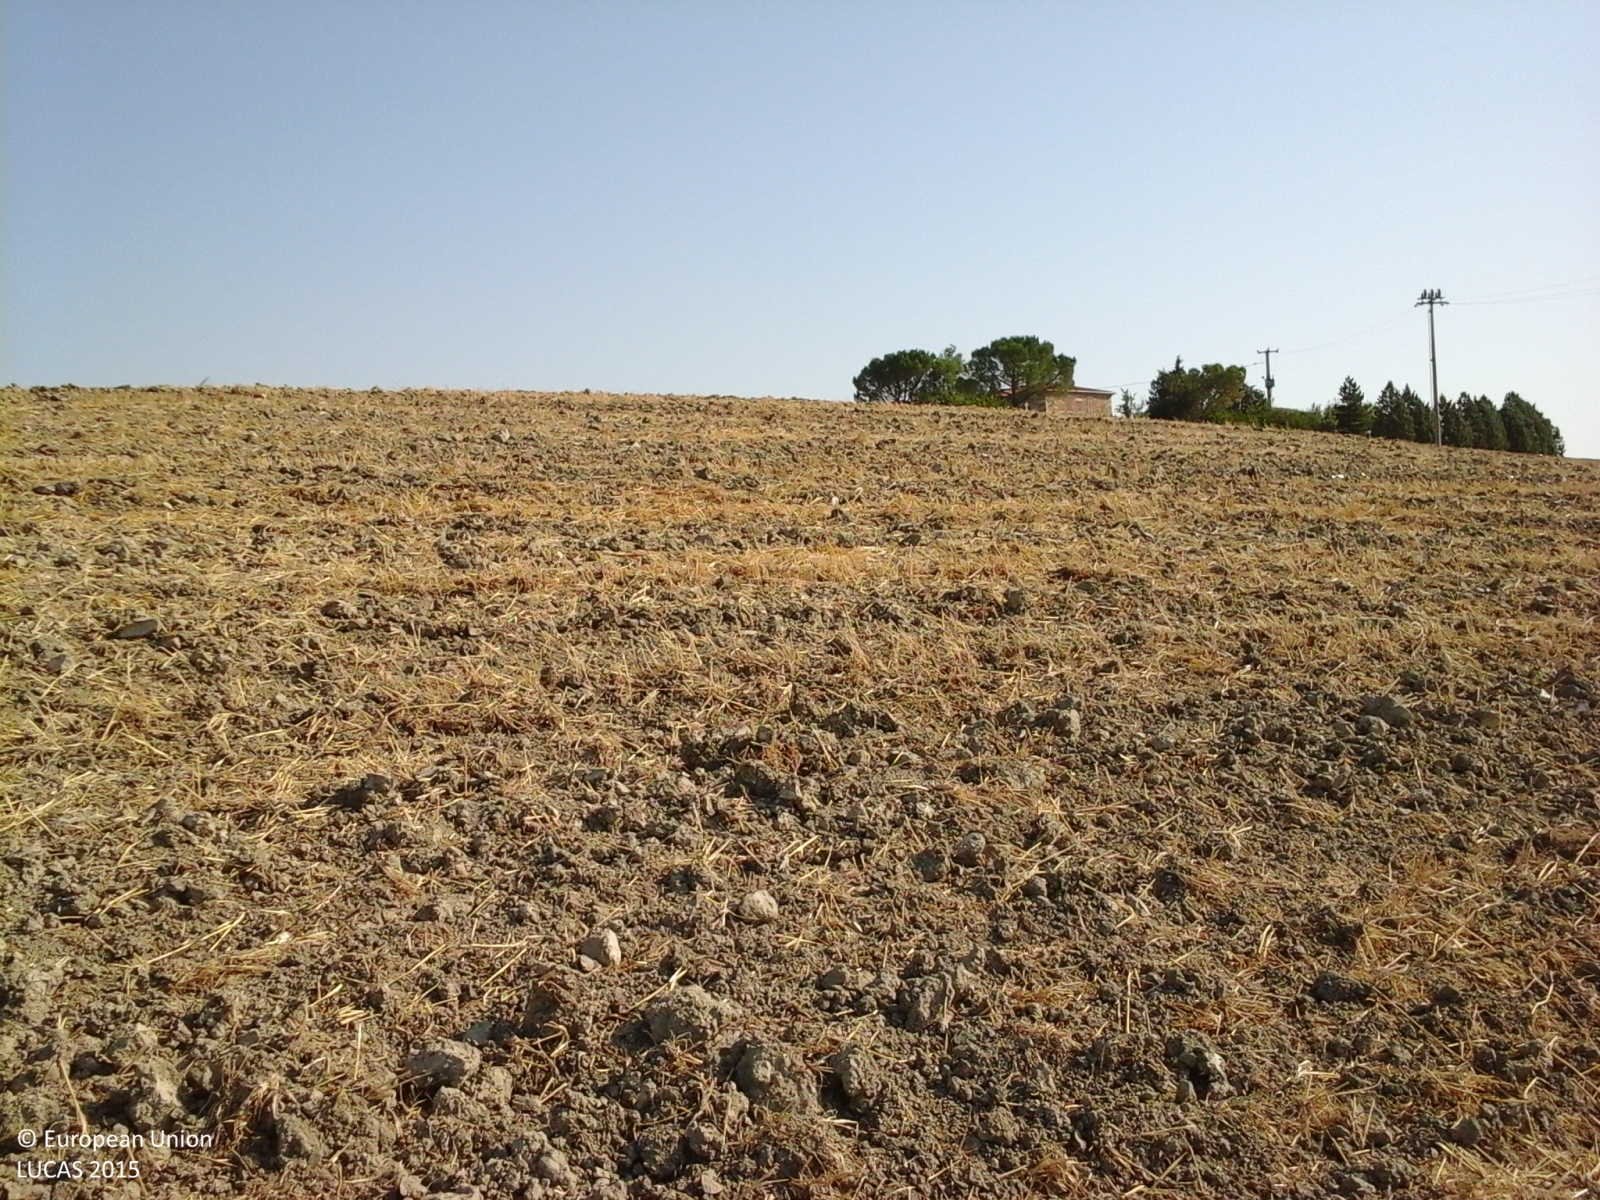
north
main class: Cropland
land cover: Durum wheat
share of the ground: > 75 %
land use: Agriculture (excluding fallow land and kitchen gardens)
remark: Harvested field
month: July
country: IT
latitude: 43.0379
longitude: 11.6520
